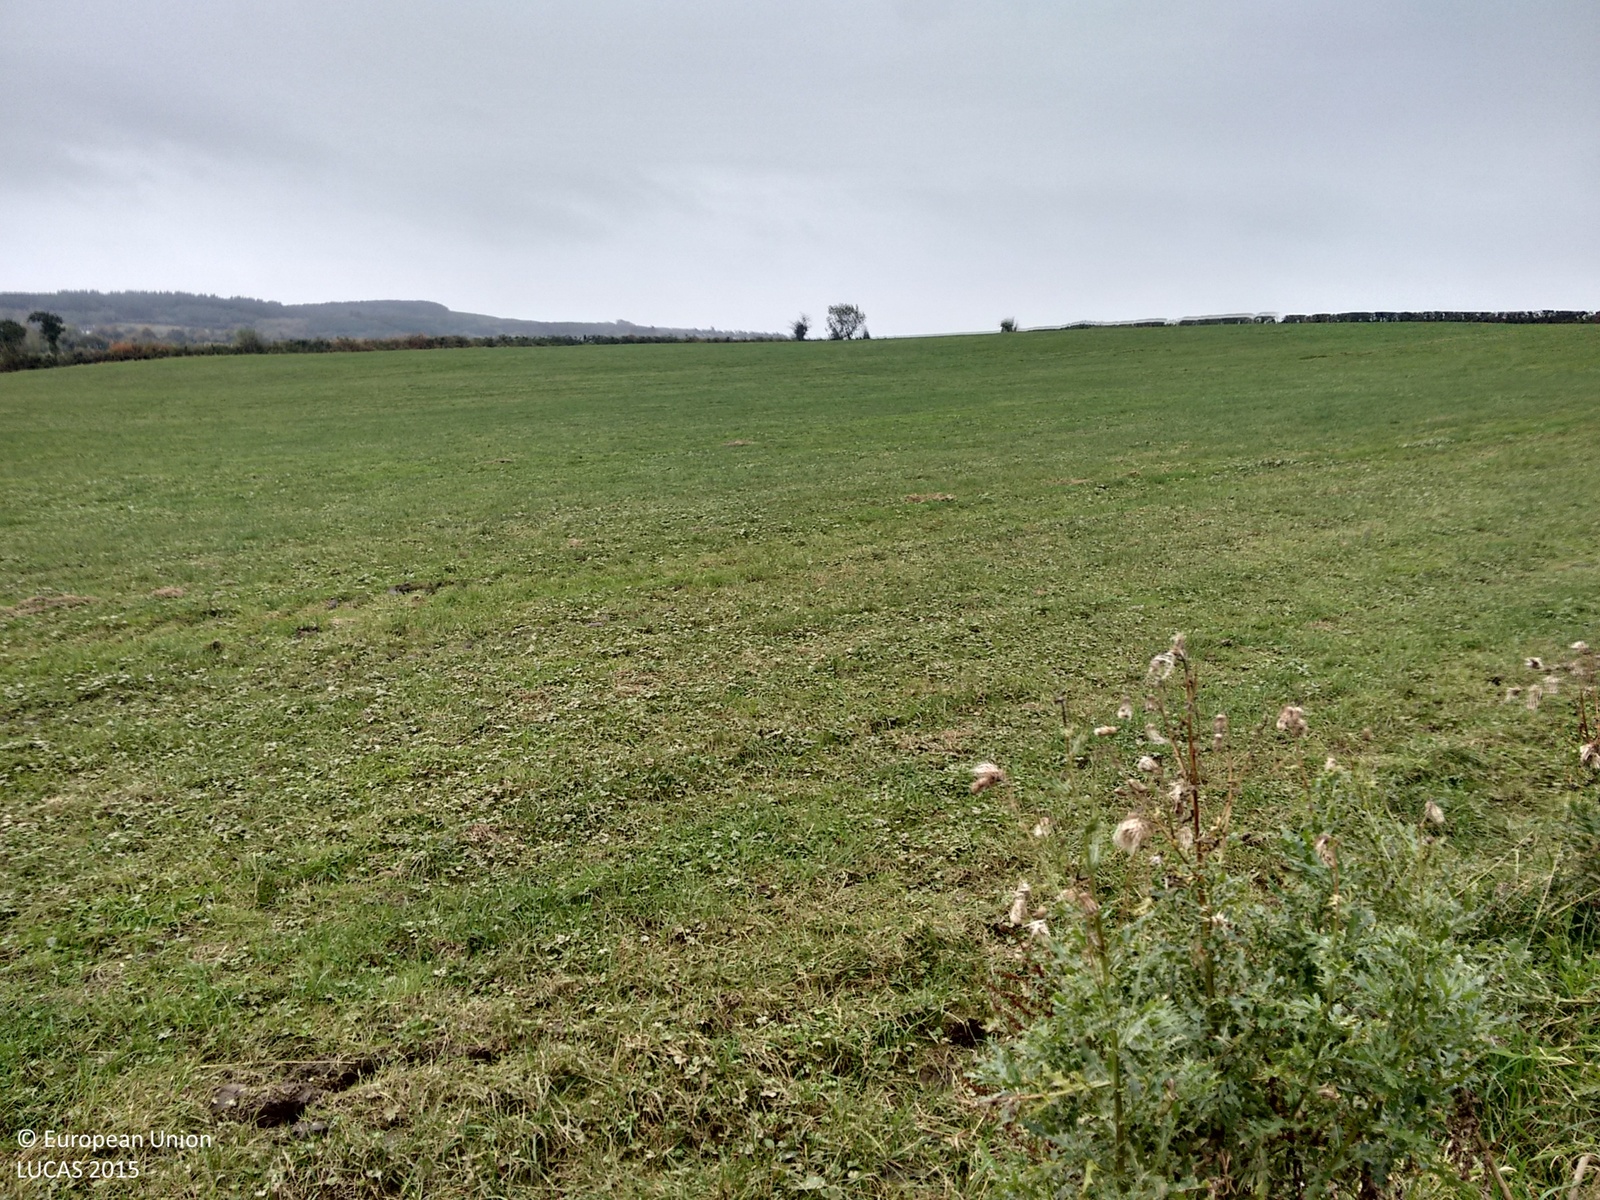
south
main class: Grassland
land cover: Grassland without tree/shrub cover
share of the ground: > 75 %
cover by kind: herbaceous plants 100 %
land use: Agriculture (excluding fallow land and kitchen gardens)
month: October
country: GB
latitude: 54.3267
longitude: -7.3577
